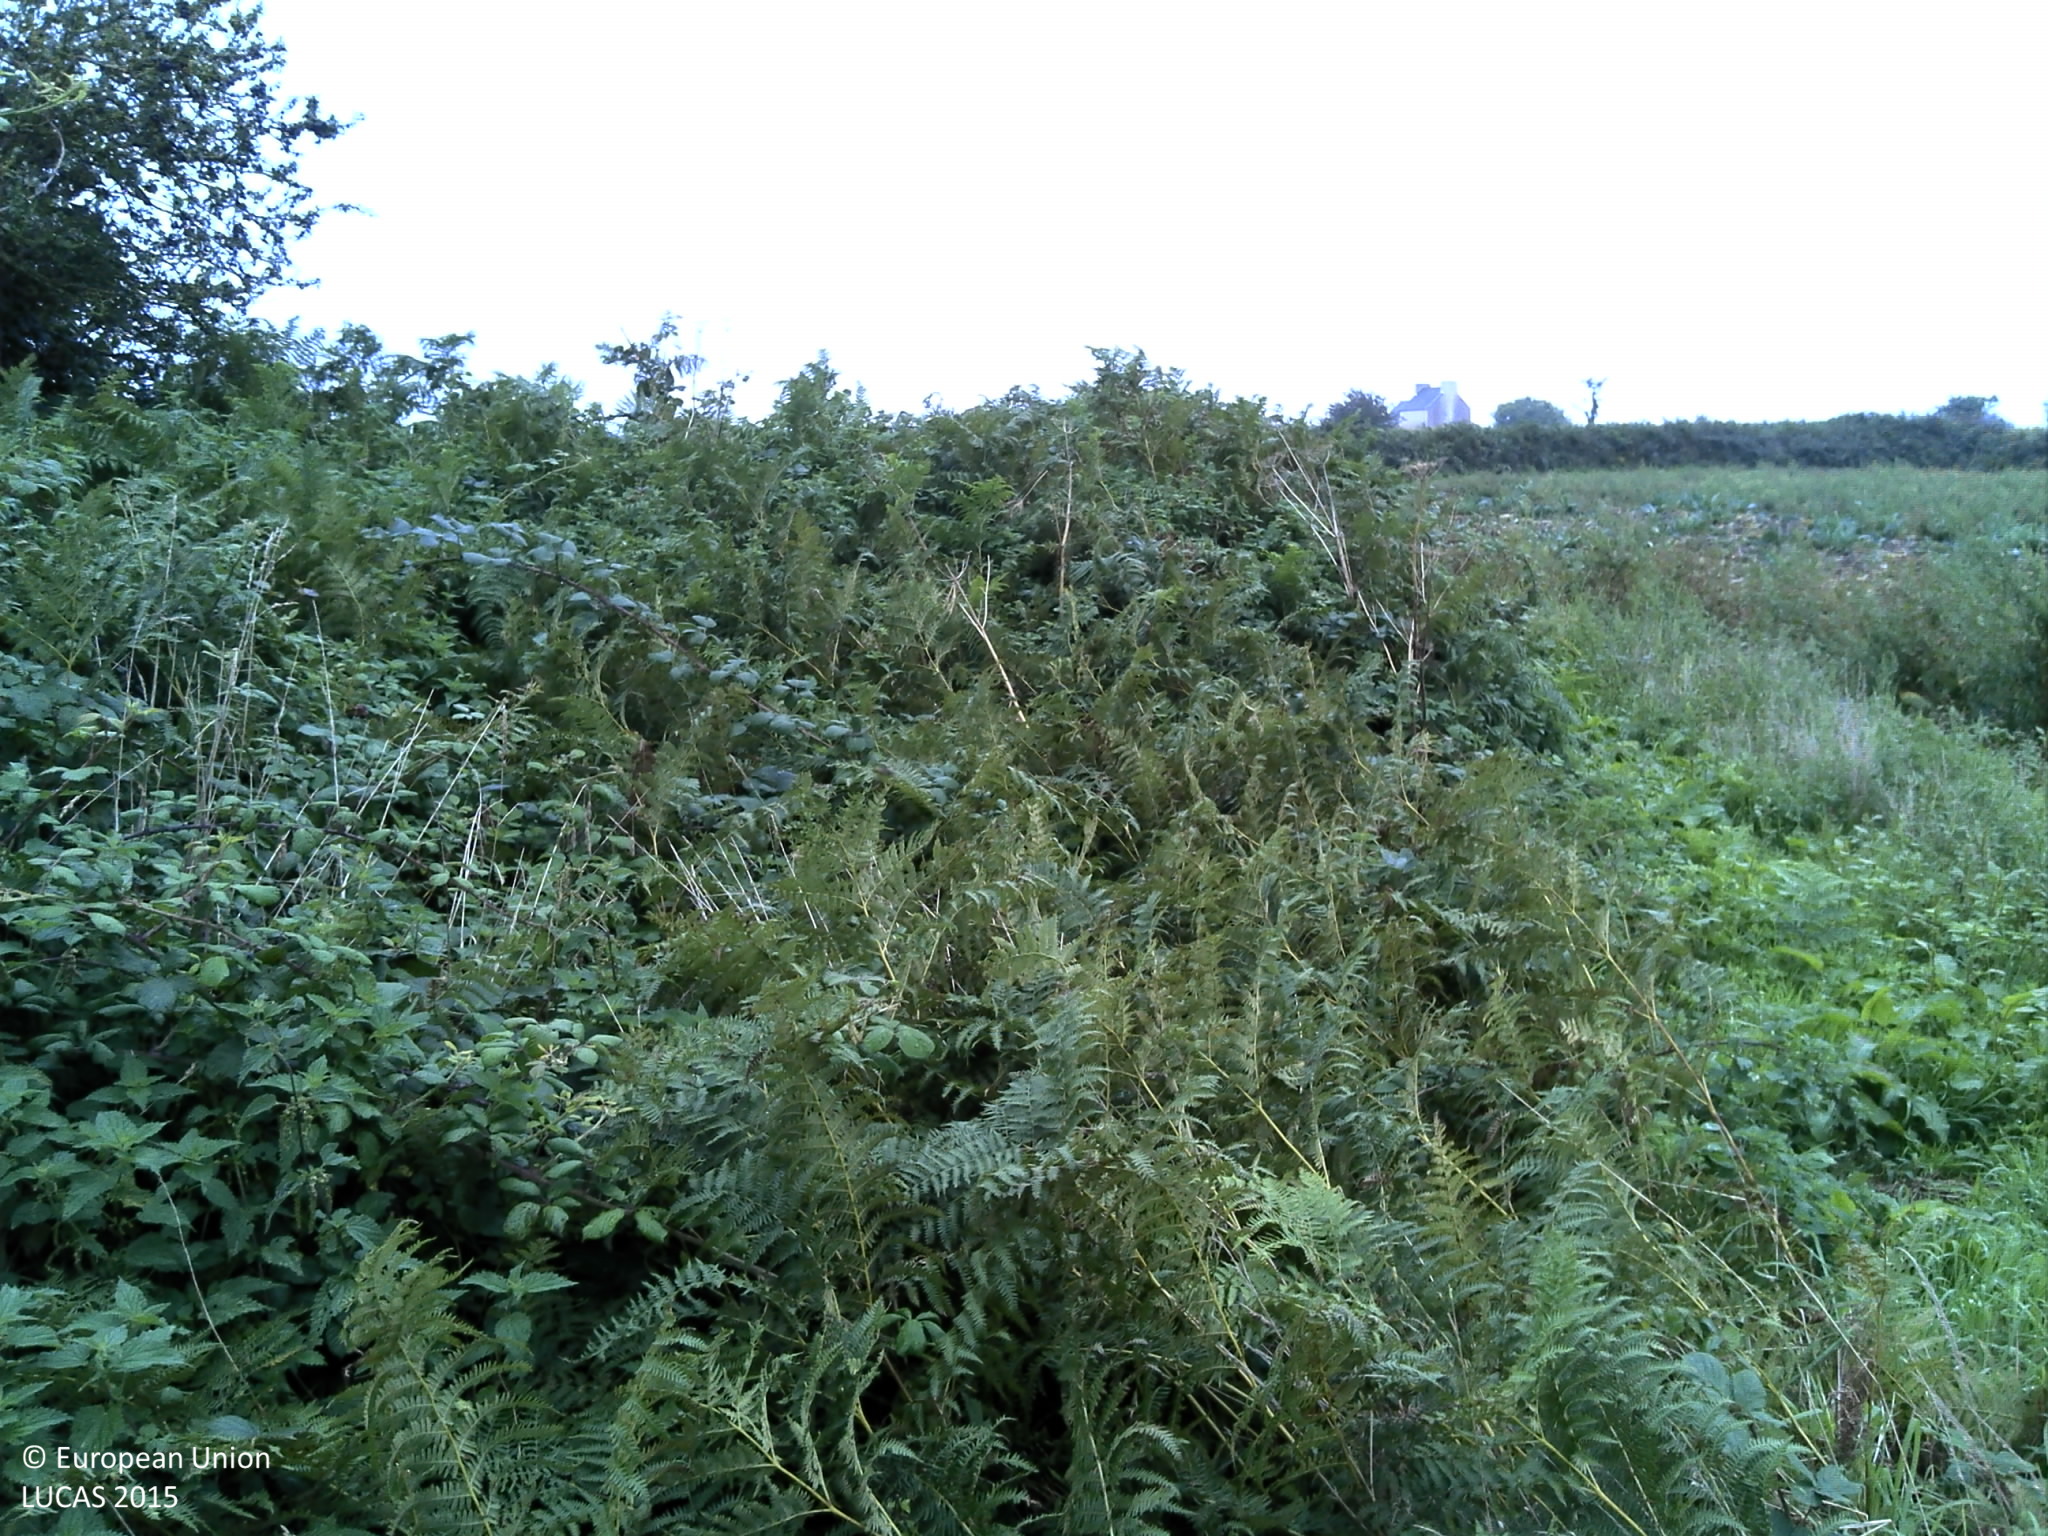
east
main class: Cropland
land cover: Maize
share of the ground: > 75 %
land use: Agriculture (excluding fallow land and kitchen gardens)
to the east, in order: Maize; Fences; Abandoned hedges; Other bare soil; Abandoned hedges; Other fresh vegetables; Grass margins; Paved roads, cycling and walking lanes; Ditches and canals; Grass margins; Clovers
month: August
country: FR
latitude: 48.6085
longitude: -4.2399
